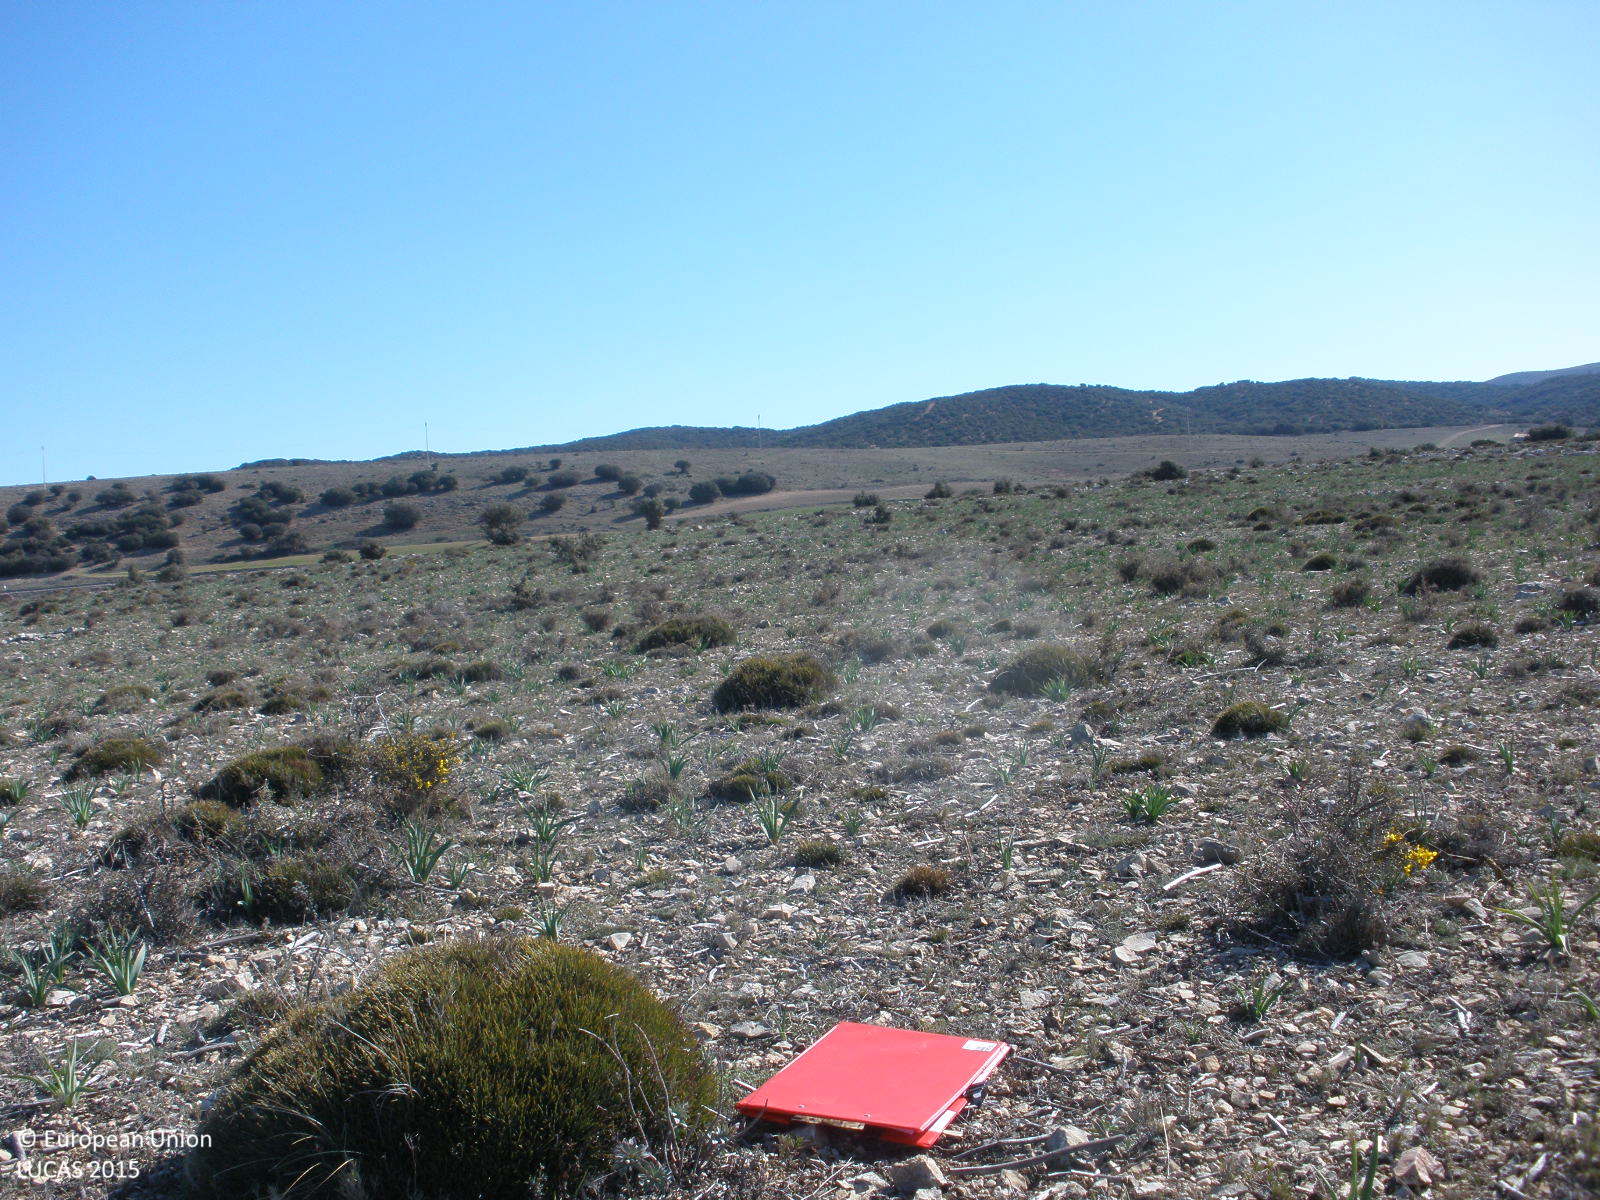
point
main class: Shrubland
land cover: Shrubland without tree cover
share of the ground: > 75 %
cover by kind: consolidated bare surface 50 %, shrubs 25 %, herbaceous plants 25 %
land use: Agriculture (excluding fallow land and kitchen gardens)
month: April
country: ES
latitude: 40.7254
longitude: -1.2990
